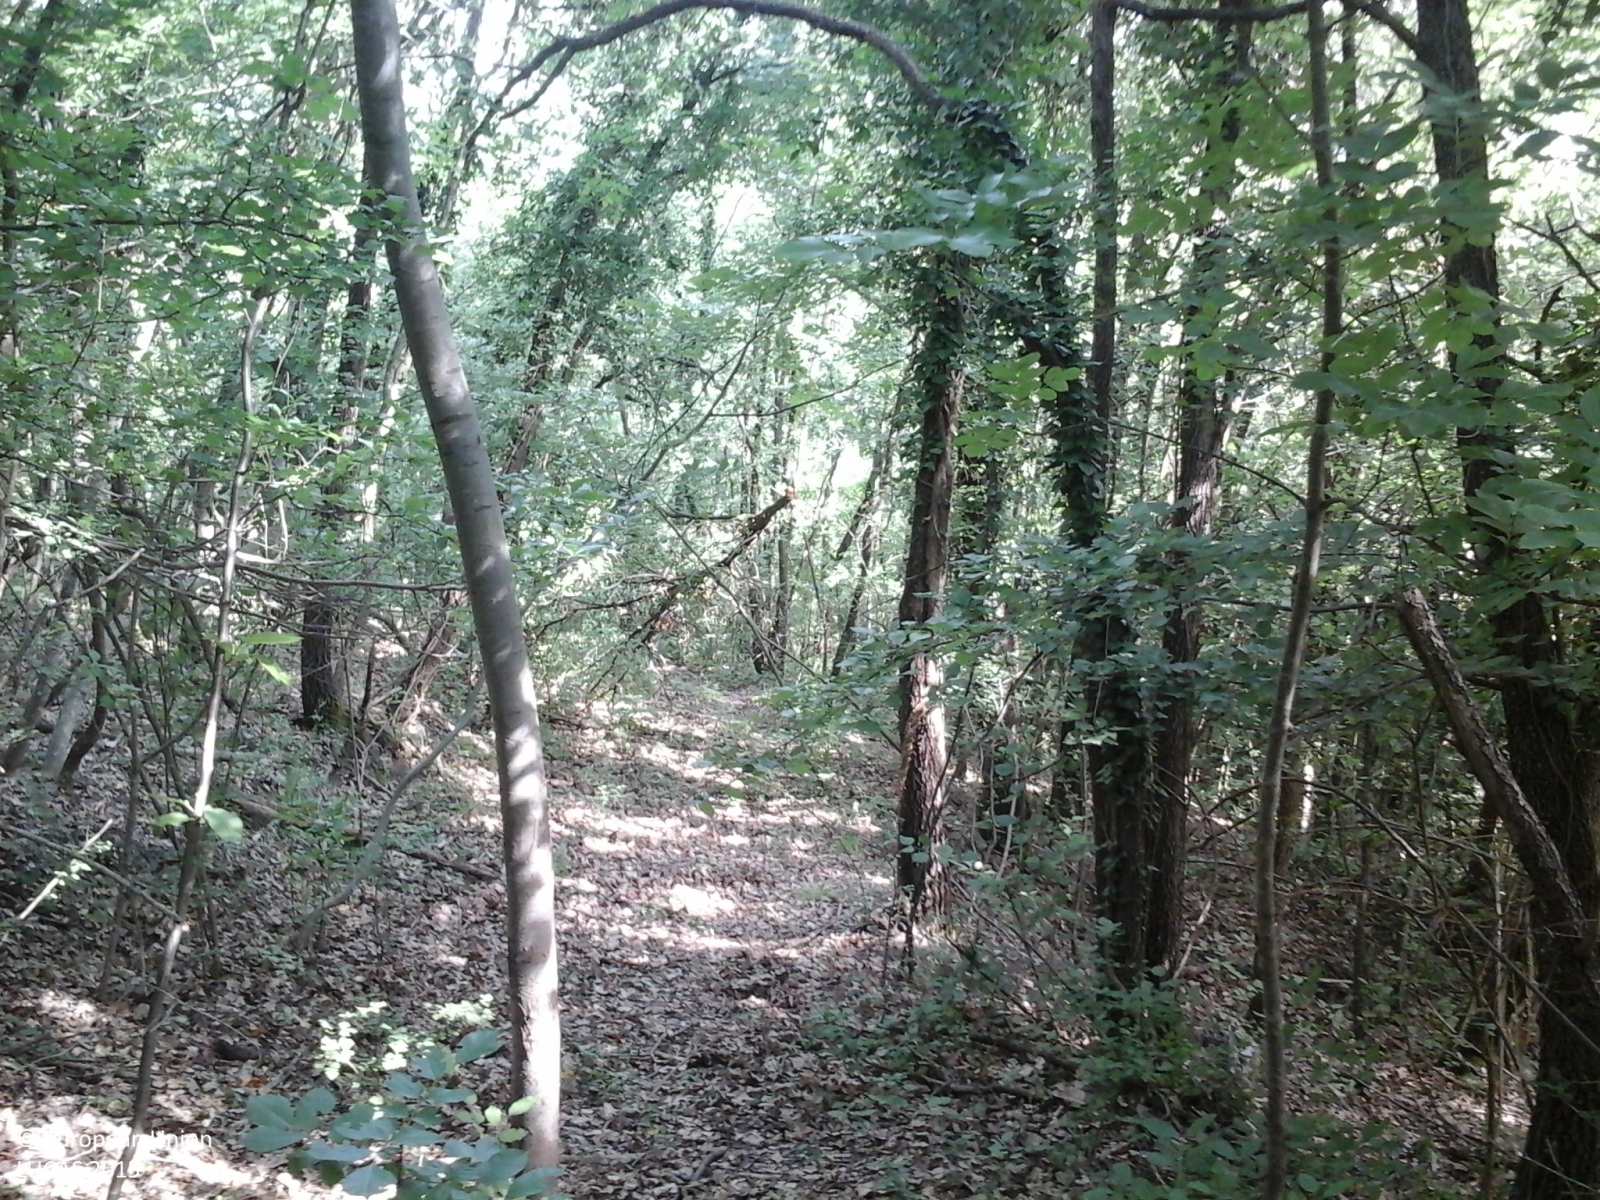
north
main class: Woodland
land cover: Broadleaved woodland
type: thermophilous deciduous forest
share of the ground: > 75 %
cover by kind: broadleaved forest trees 90 %, shrubs 10 %
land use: Forestry
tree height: > 5 m
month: June
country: IT
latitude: 44.2655
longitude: 11.6373
